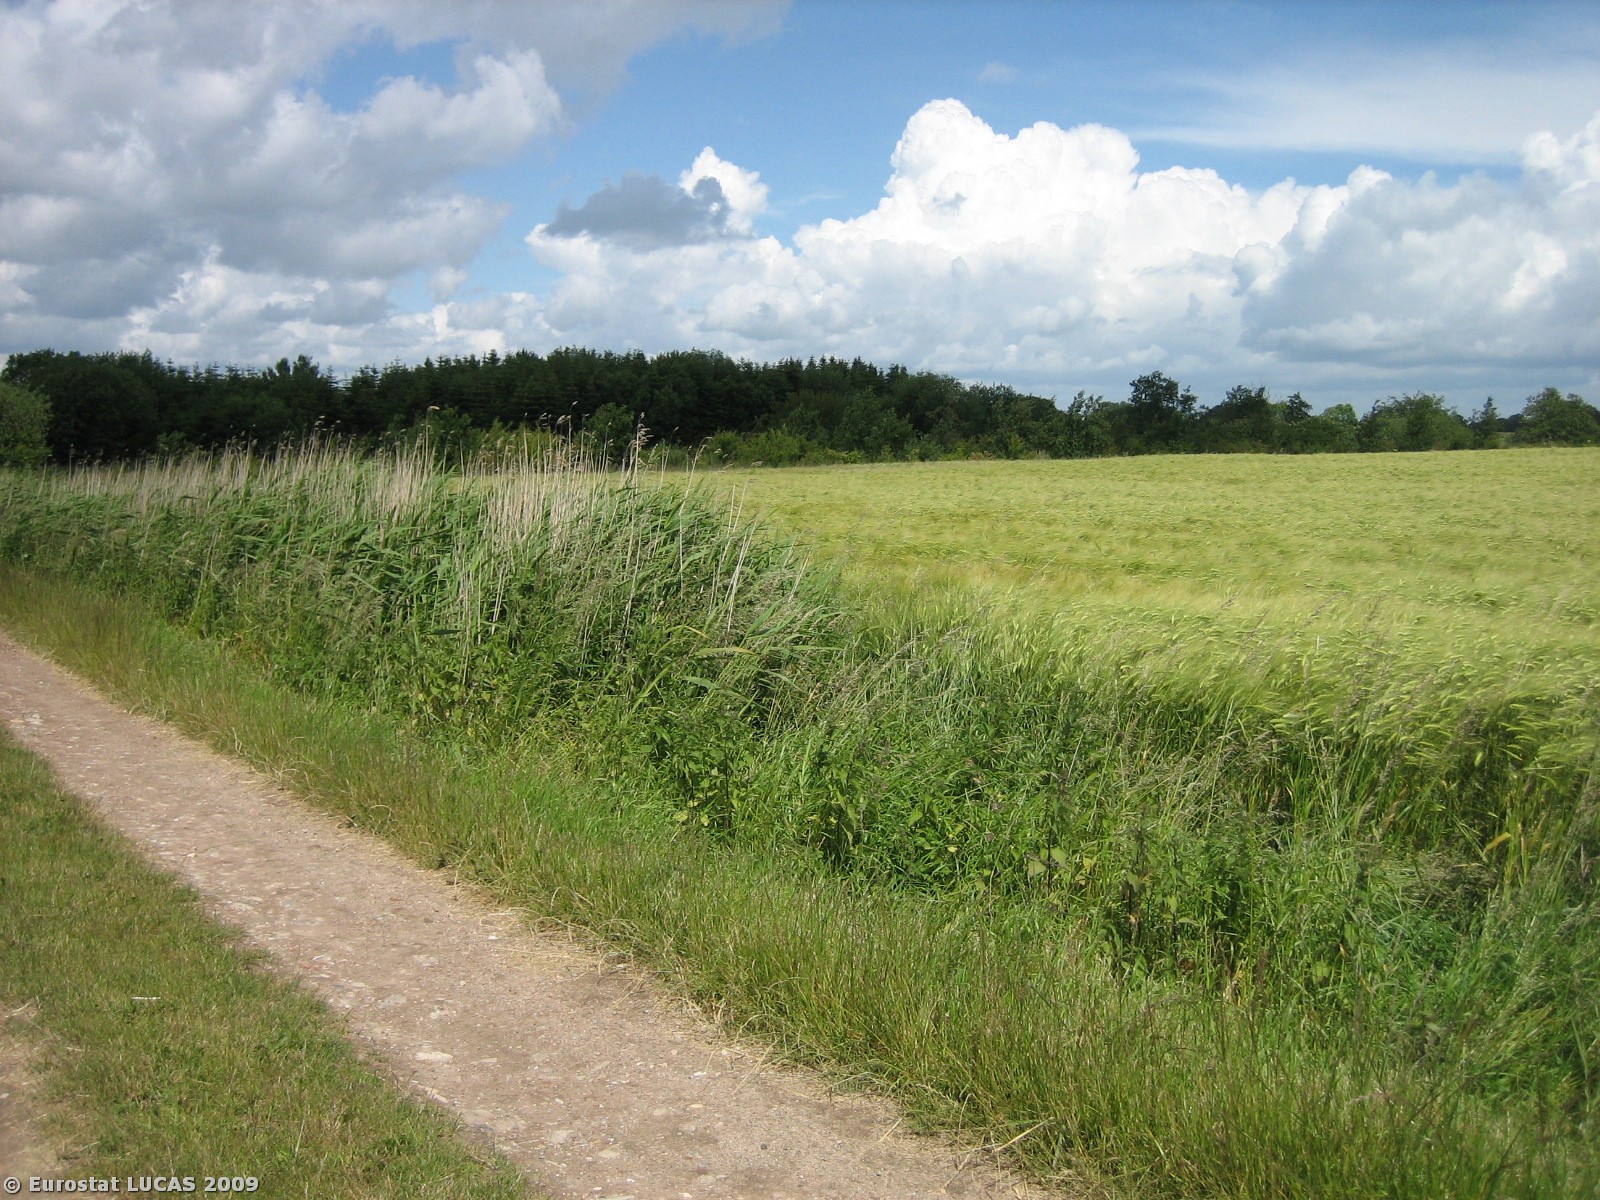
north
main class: Cropland
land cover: Common wheat
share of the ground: > 75 %
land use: Agriculture (excluding fallow land and kitchen gardens)
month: June
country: DK
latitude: 55.6124
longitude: 9.7938
